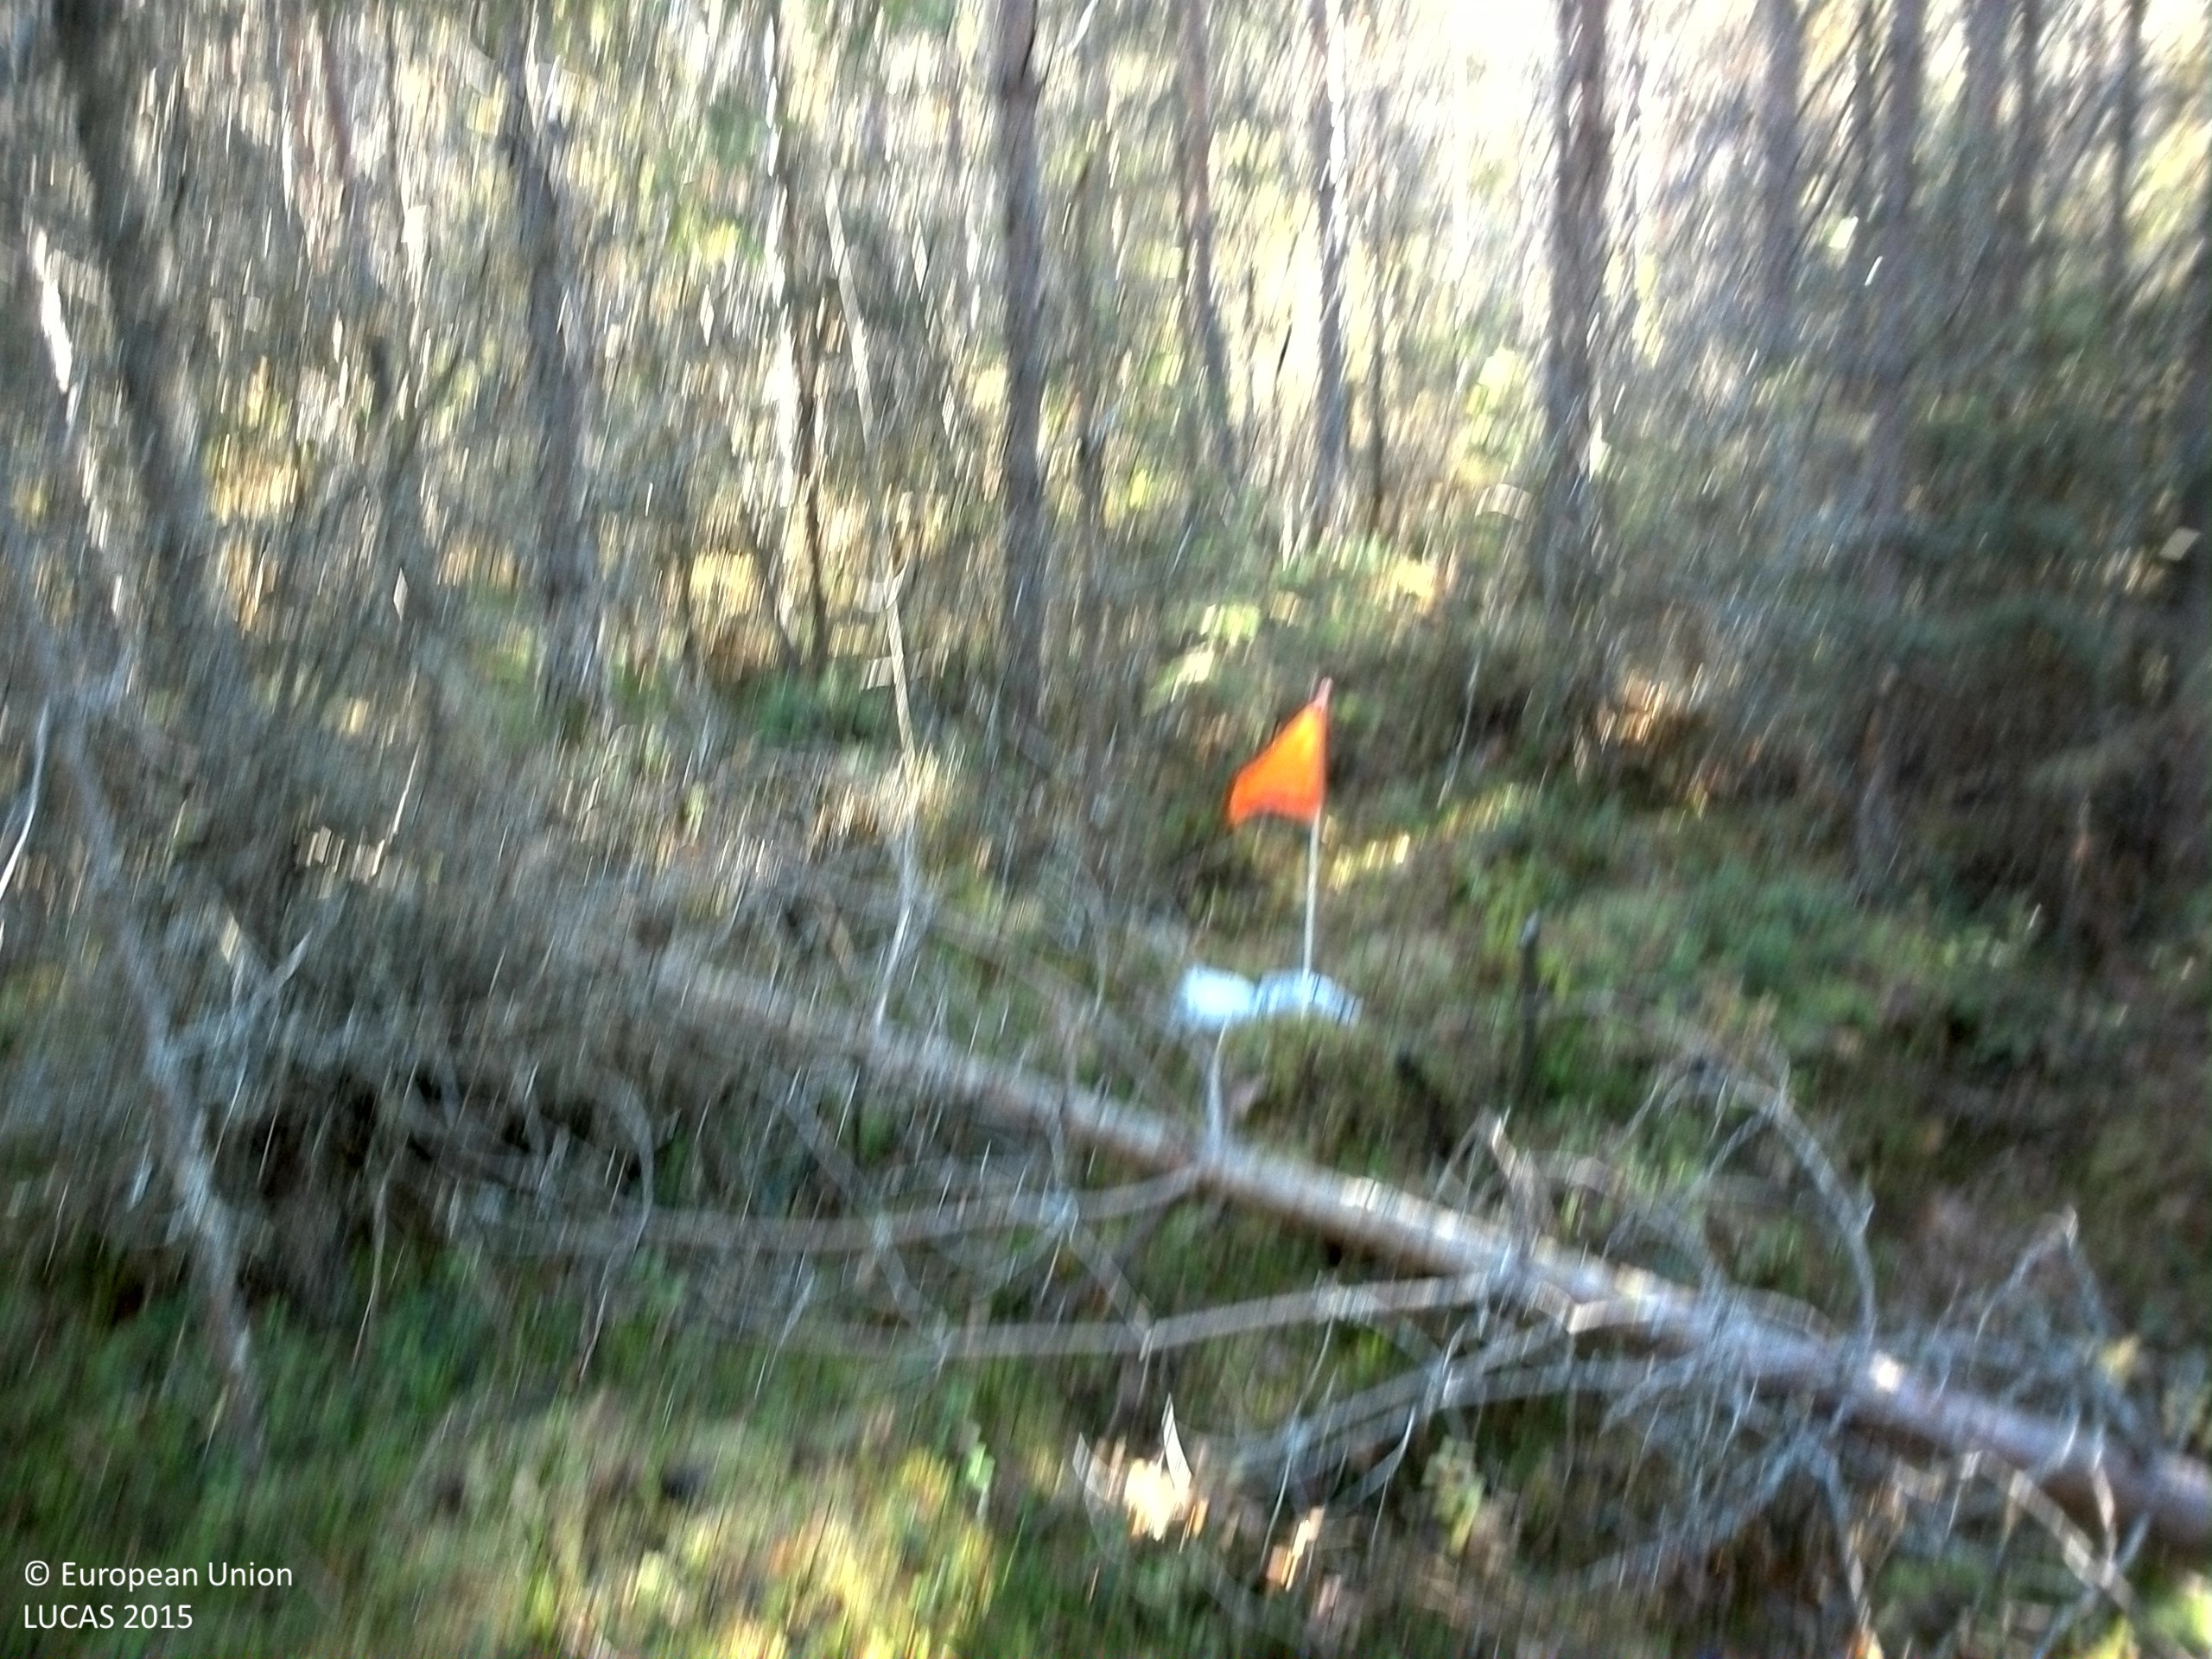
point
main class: Woodland
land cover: Pine dominated coniferous woodland
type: boreal forest
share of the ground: > 75 %
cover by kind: coniferous forest trees 75 %, shrubs 15 %, lichens and mosses 10 %
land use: Forestry
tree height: > 5 m
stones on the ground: < 10 %
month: October
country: SE
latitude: 61.1269
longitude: 14.2381
